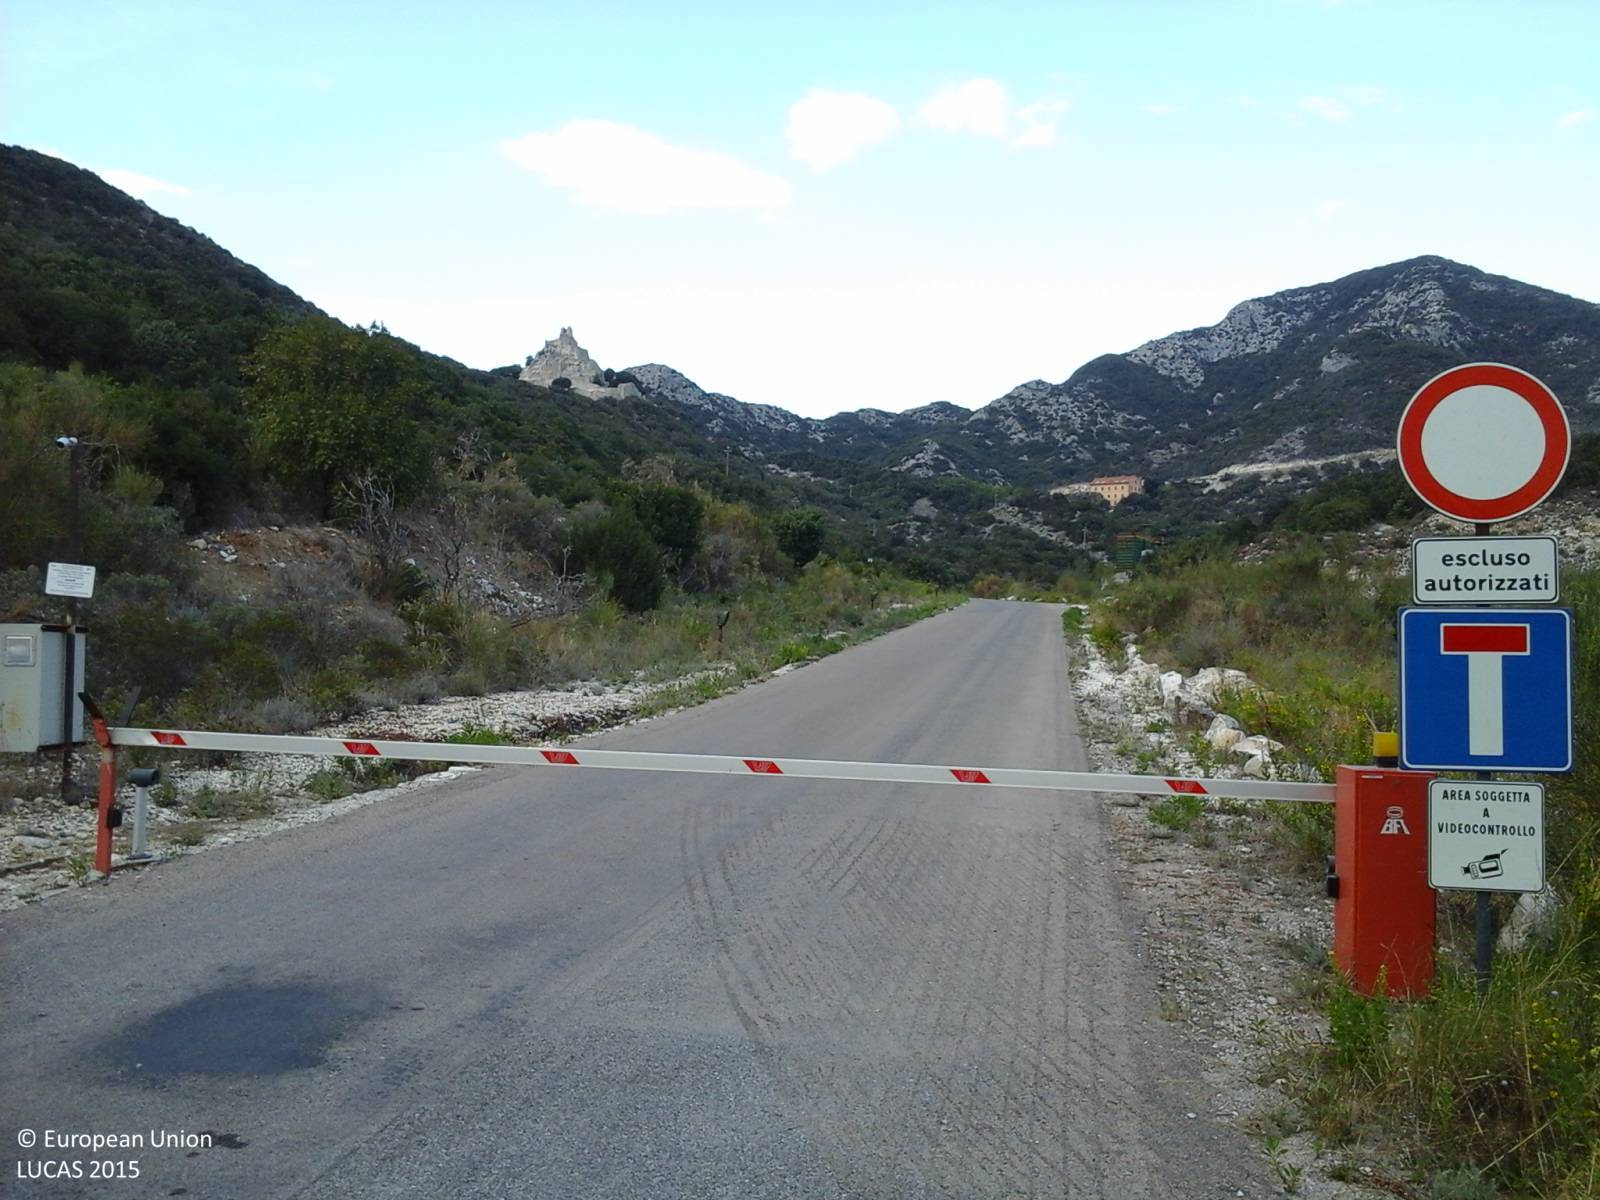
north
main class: Woodland
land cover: Broadleaved woodland
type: thermophilous deciduous forest
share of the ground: > 75 %
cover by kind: broadleaved forest trees 100 %
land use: Forestry
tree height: > 5 m
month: September
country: IT
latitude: 43.0856
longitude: 10.6000
